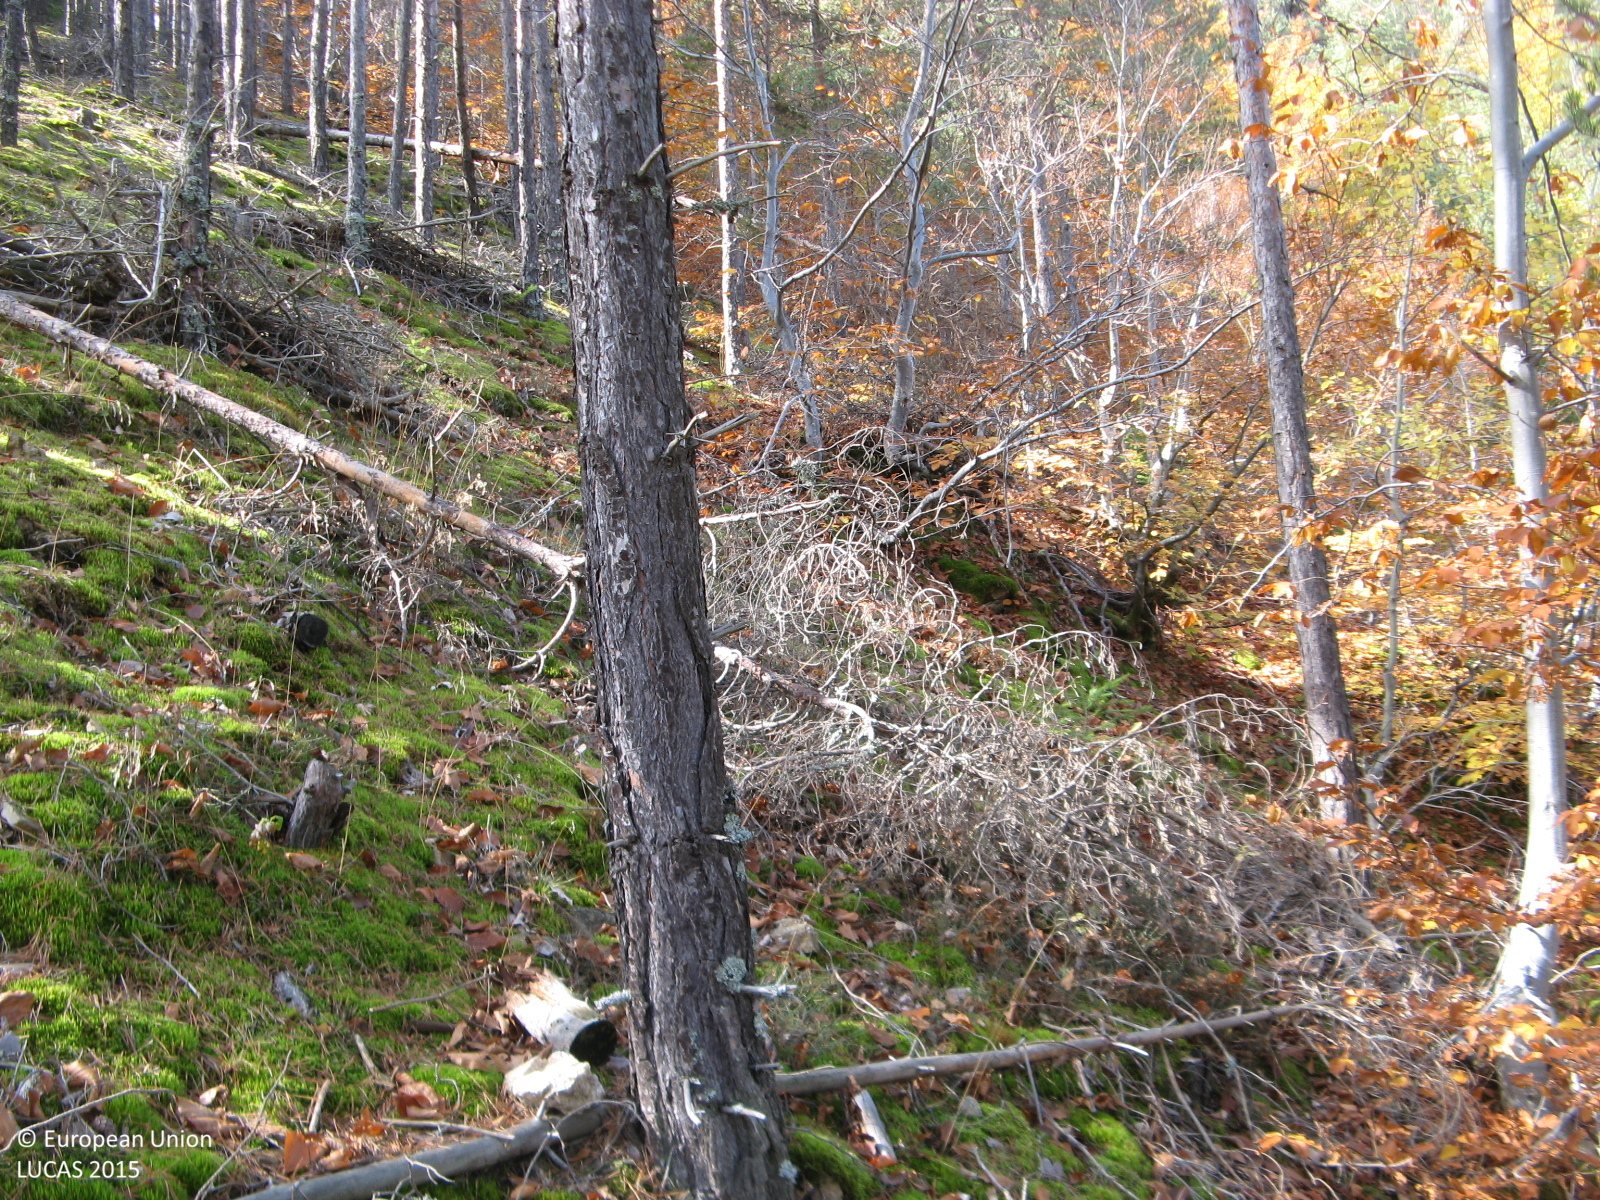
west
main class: Woodland
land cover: Pine dominated mixed woodland
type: alpine coniferous forest
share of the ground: > 75 %
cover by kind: coniferous forest trees 70 %, broadleaved forest trees 25 %, lichens and mosses 5 %
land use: Forestry
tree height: > 5 m
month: October
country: BG
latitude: 41.5343
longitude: 24.8483
